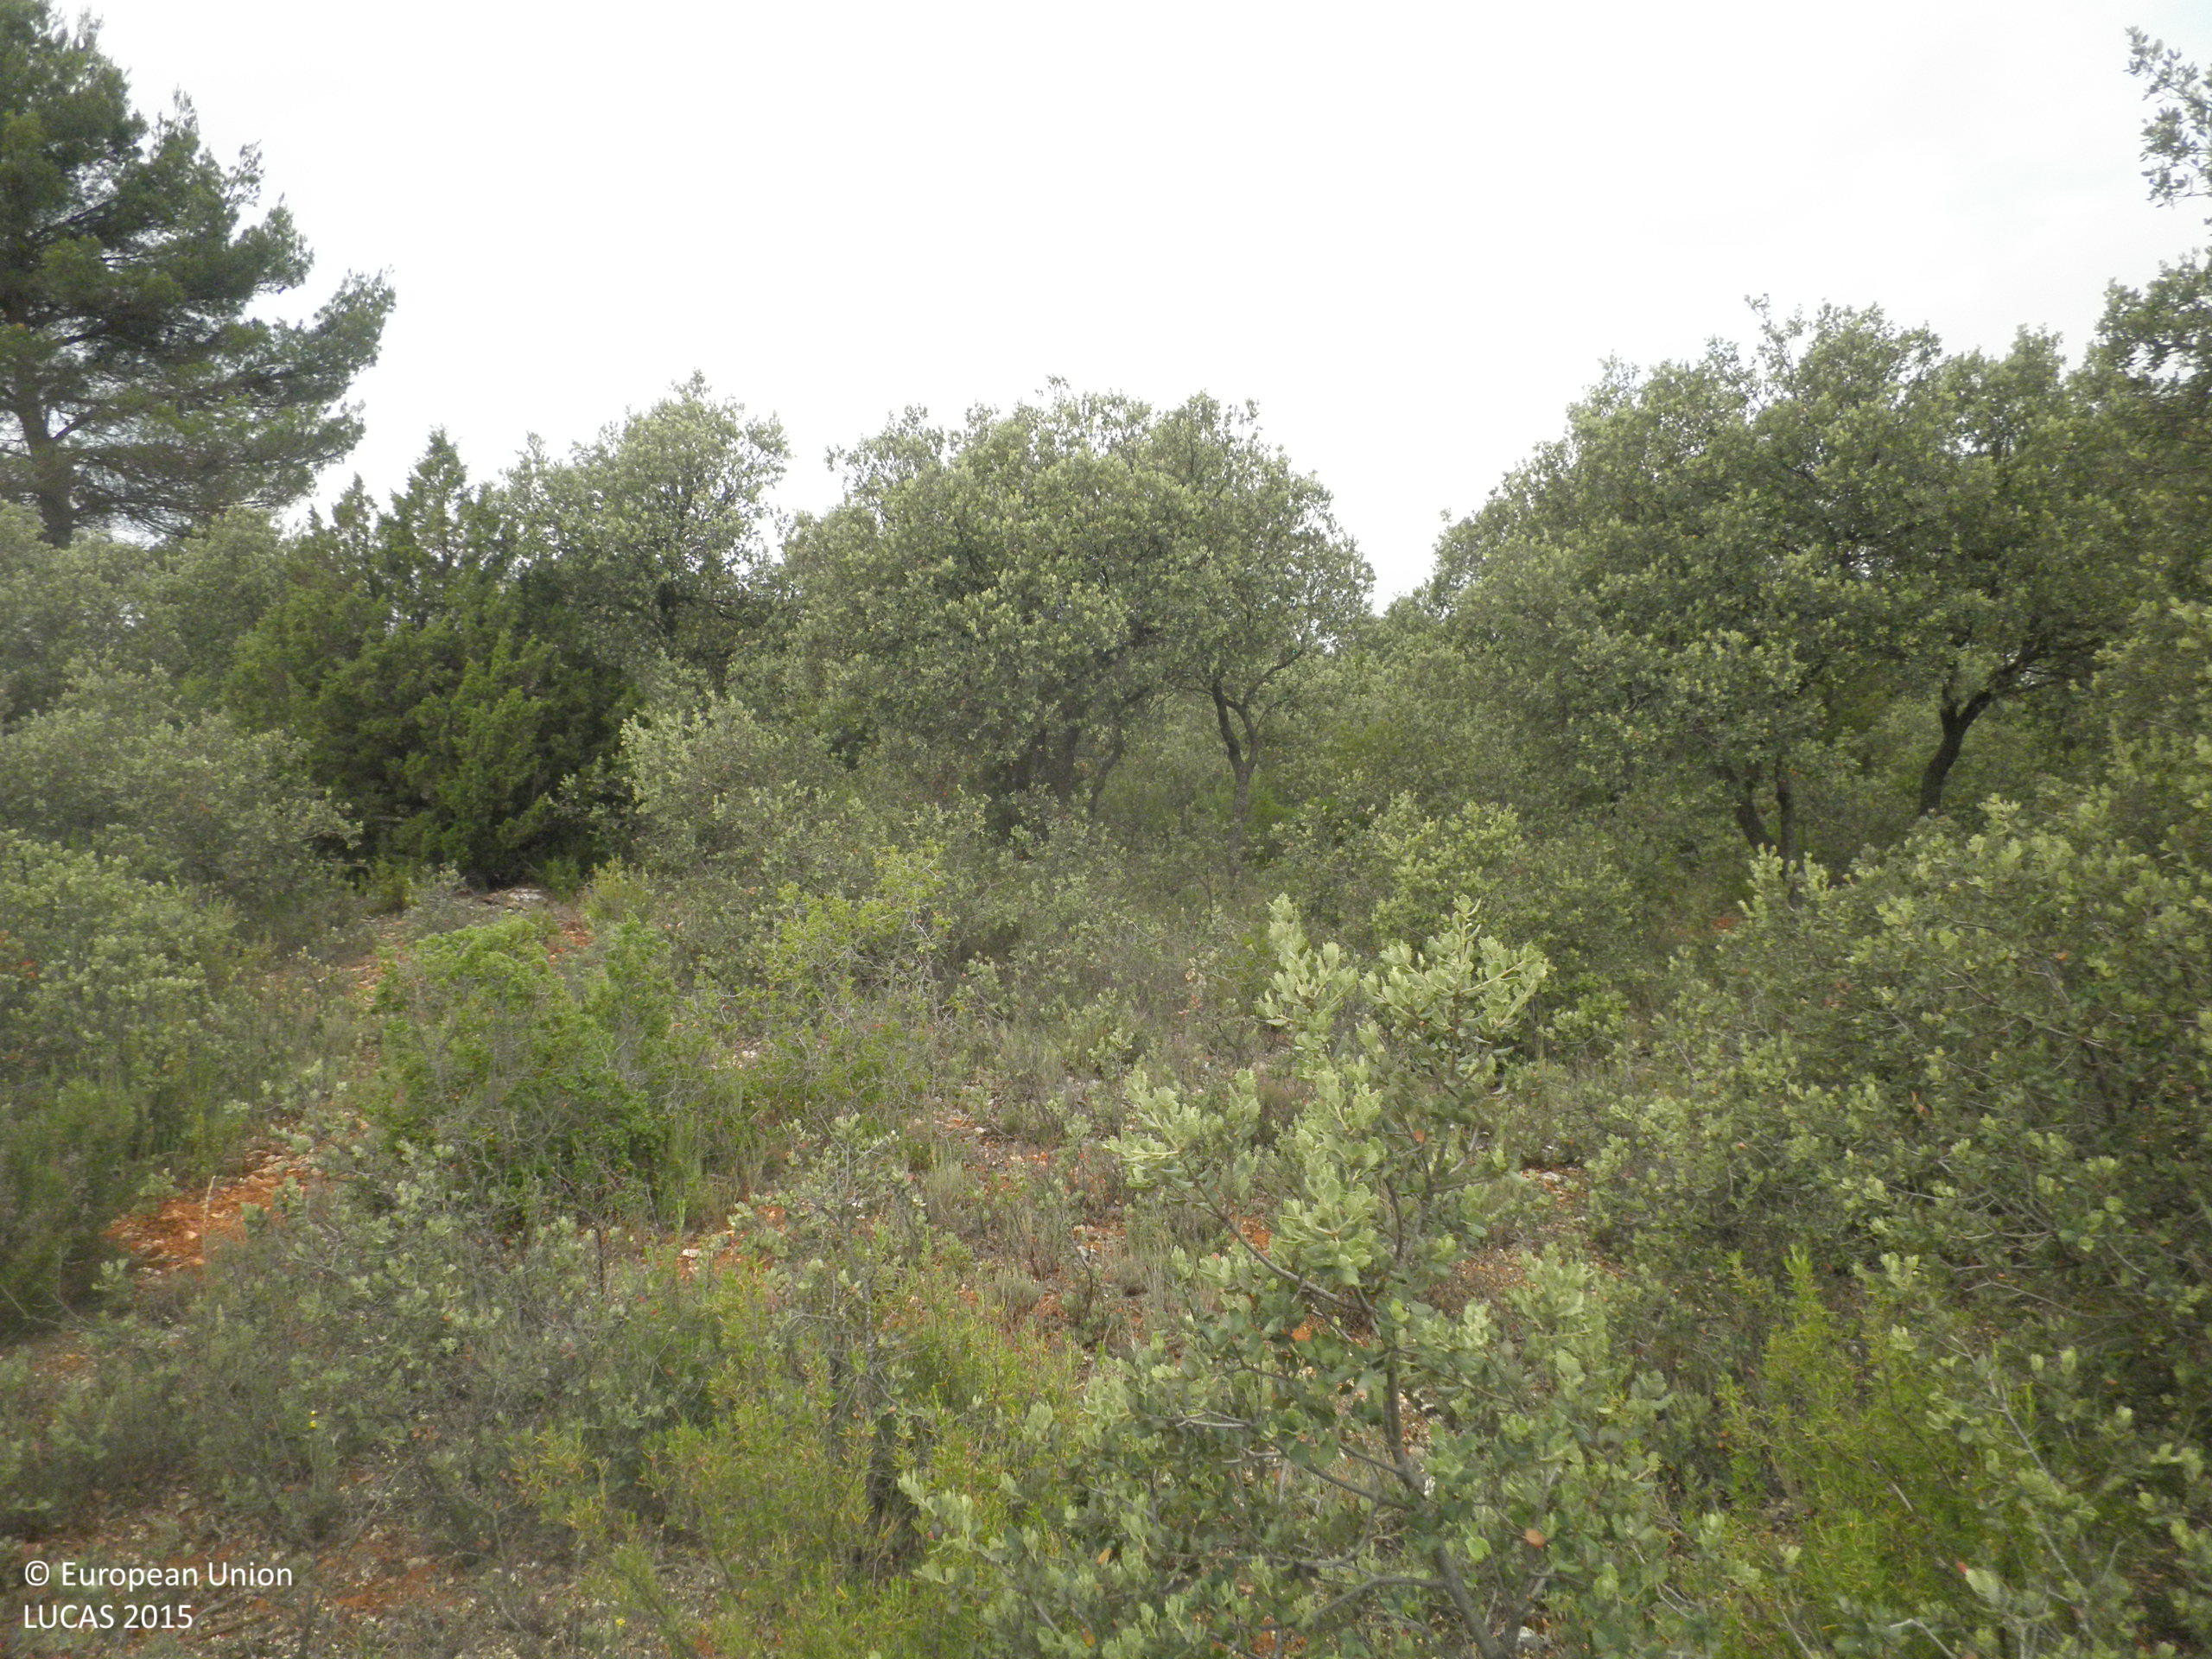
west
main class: Woodland
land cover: Broadleaved woodland
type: broadleaved evergreen forest
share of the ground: 25 - 50 %
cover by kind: shrubs 35 %, unconsolidated bare surface 30 %, broadleaved forest trees 25 %, herbaceous plants 10 %
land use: Semi-natural and natural areas not in use
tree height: < 5 m
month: June
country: ES
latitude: 39.5642
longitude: -1.7041
